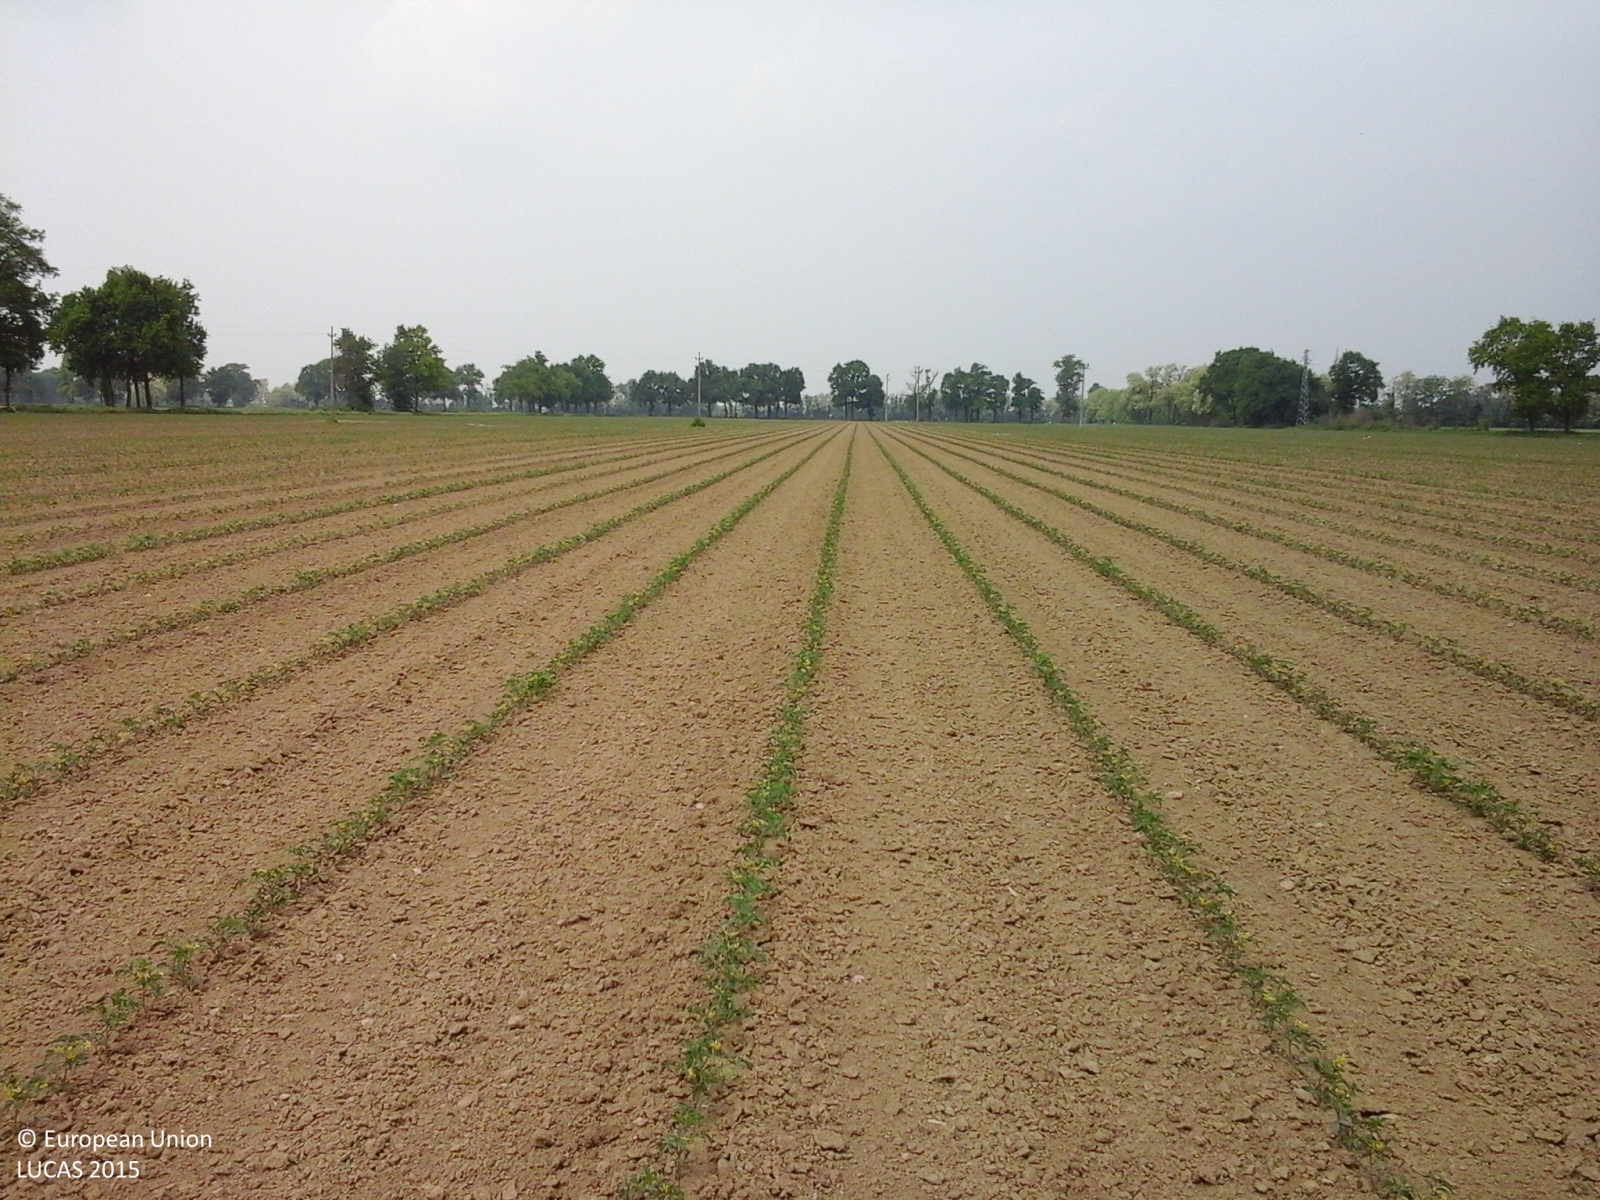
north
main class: Cropland
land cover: Tomatoes
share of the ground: < 10 %
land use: Agriculture (excluding fallow land and kitchen gardens)
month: May
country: IT
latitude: 44.9210
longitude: 8.8241
